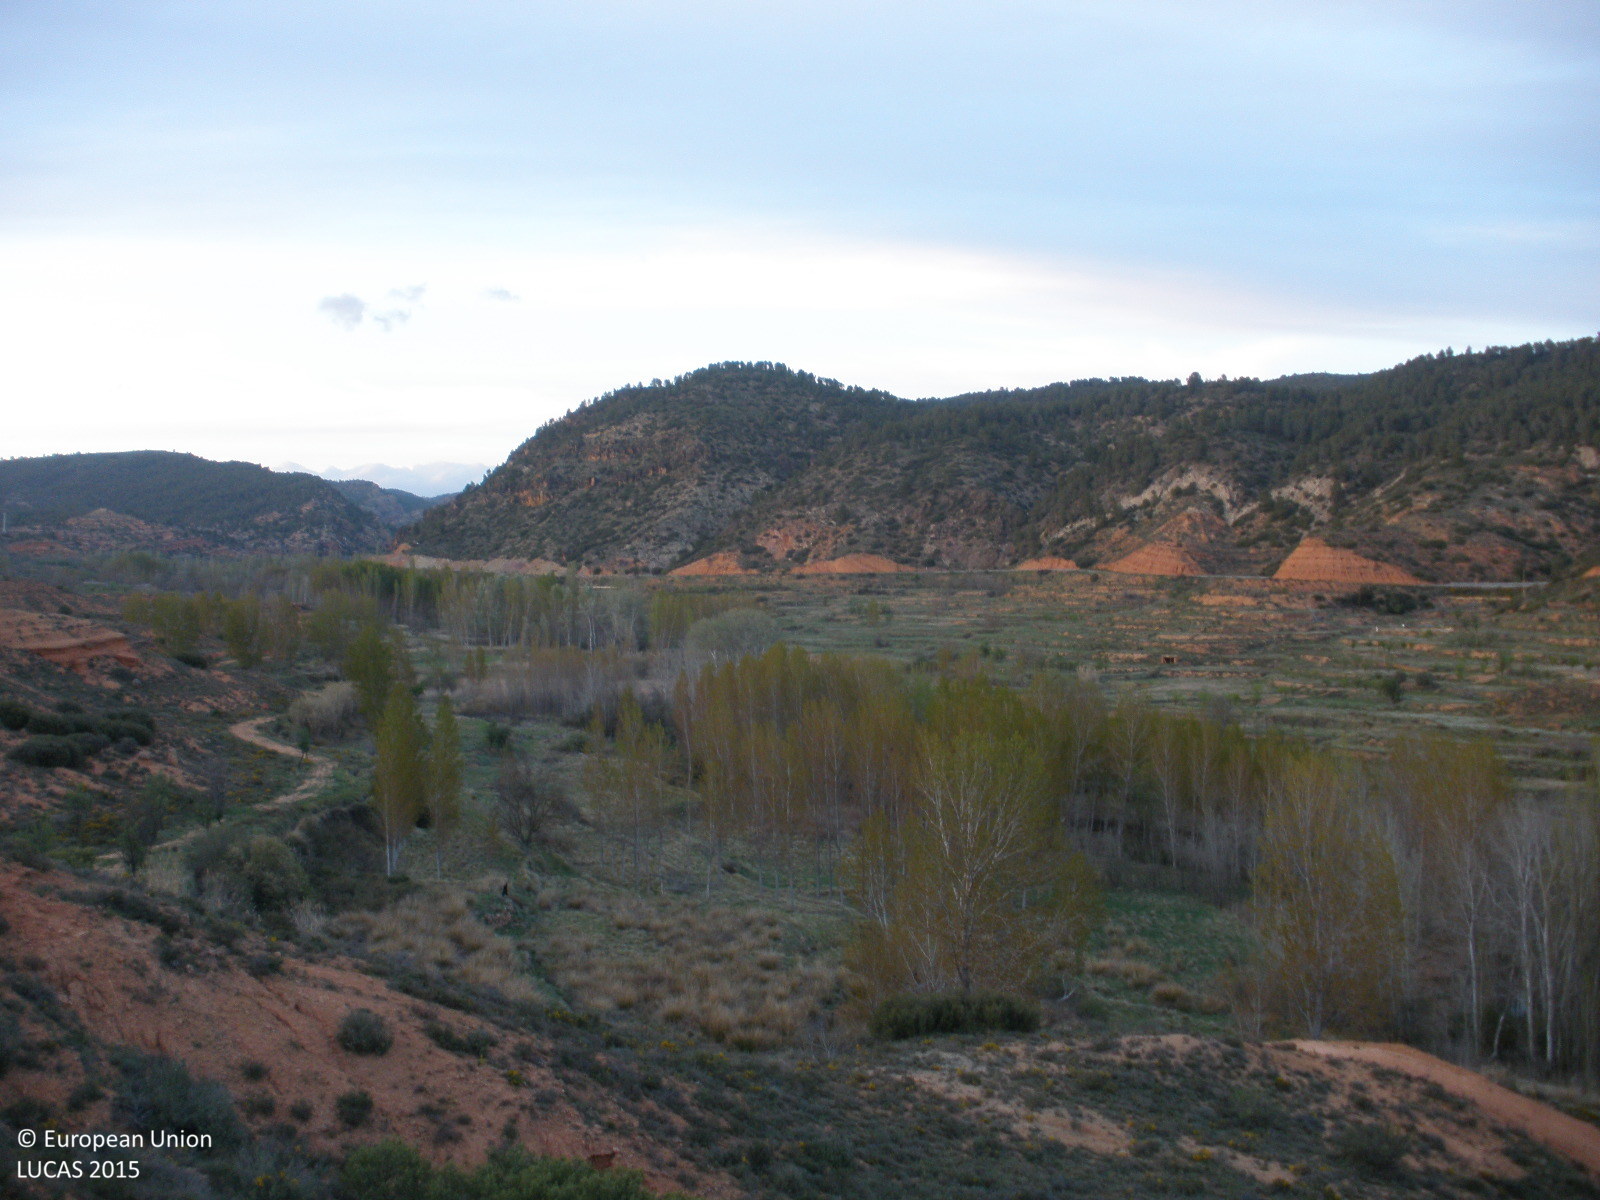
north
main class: Shrubland
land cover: Shrubland without tree cover
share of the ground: > 75 %
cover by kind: shrubs 90 %, herbaceous plants 5 %, consolidated bare surface 5 %
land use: Semi-natural and natural areas not in use
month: April
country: ES
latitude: 40.1660
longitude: -1.2466
